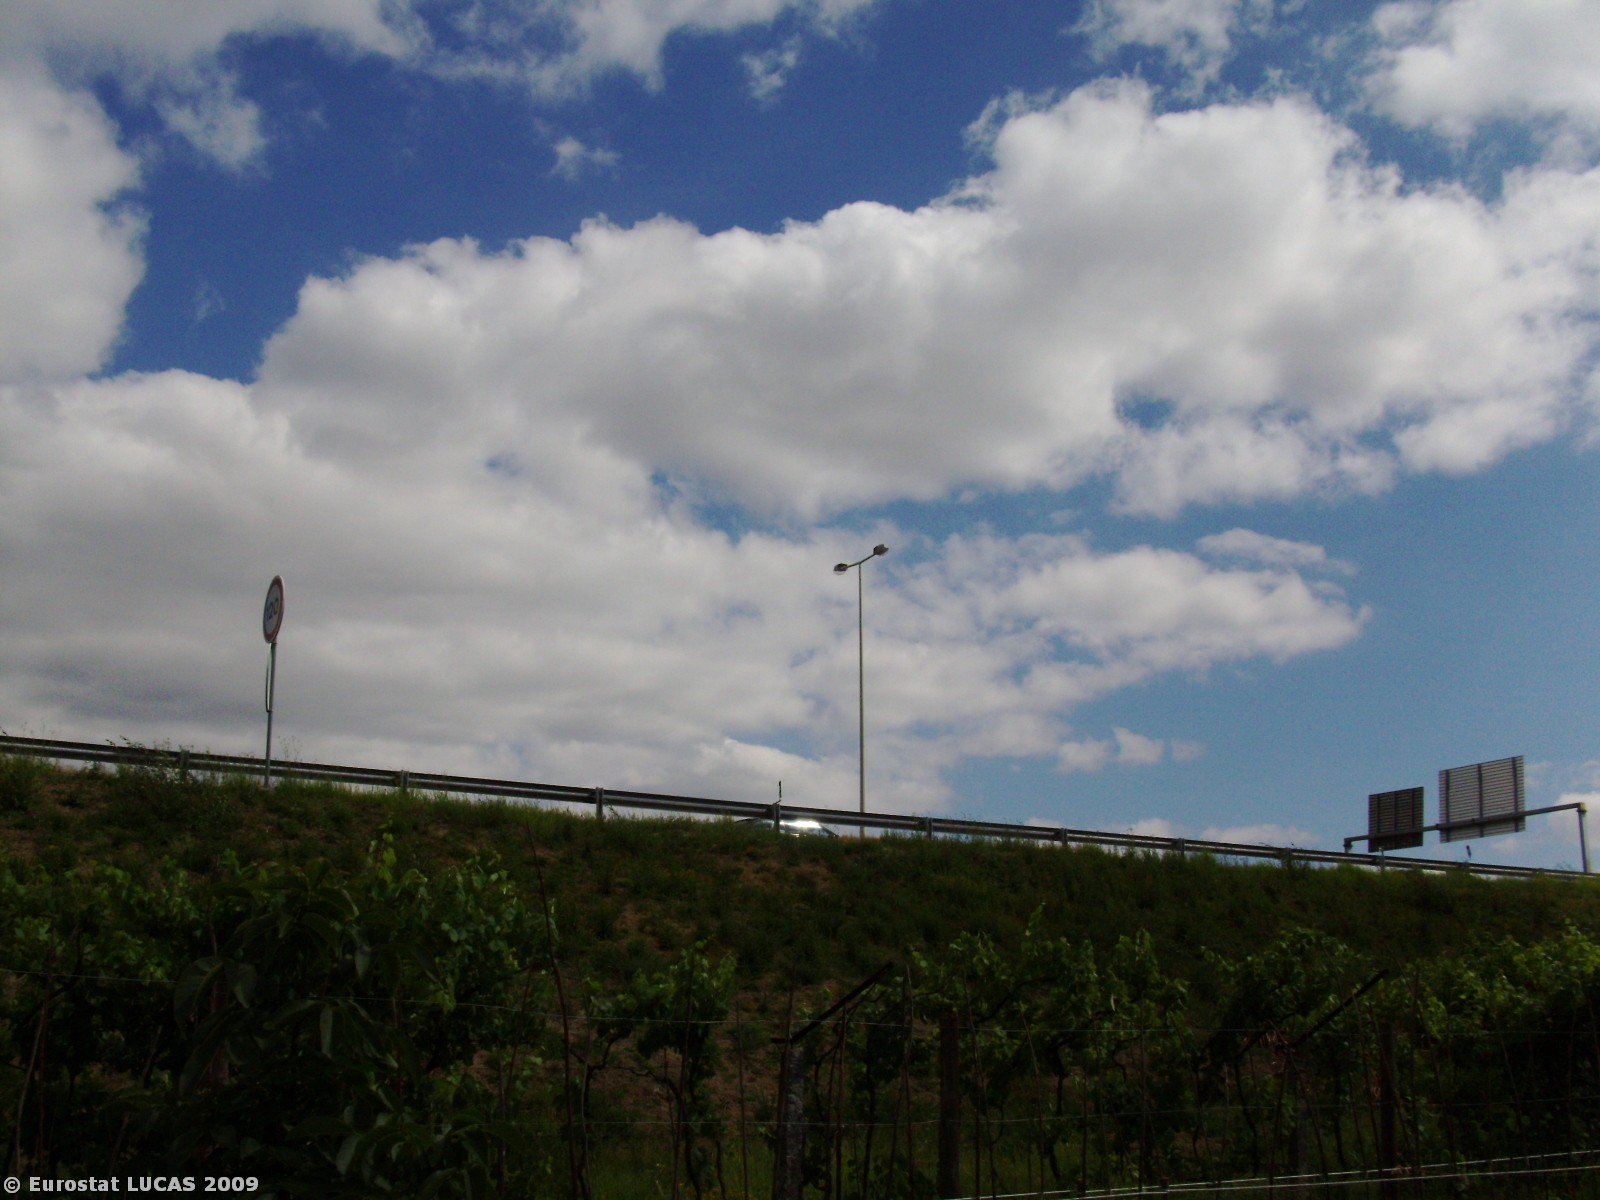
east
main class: Cropland
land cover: Potatoes
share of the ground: 50 - 75 %
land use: Agriculture (excluding fallow land and kitchen gardens)
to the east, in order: Potatoes; Vineyards; Spontaneously vegetated surfaces; Fences; Paved roads, cycling and walking lanes; Fences; Spontaneously vegetated surfaces; Arable land (only in case pi); Vineyards; Arable land (only in case pi); Vineyards; Arable land (only in case pi)
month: June
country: PT
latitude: 41.4007
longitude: -8.4652
